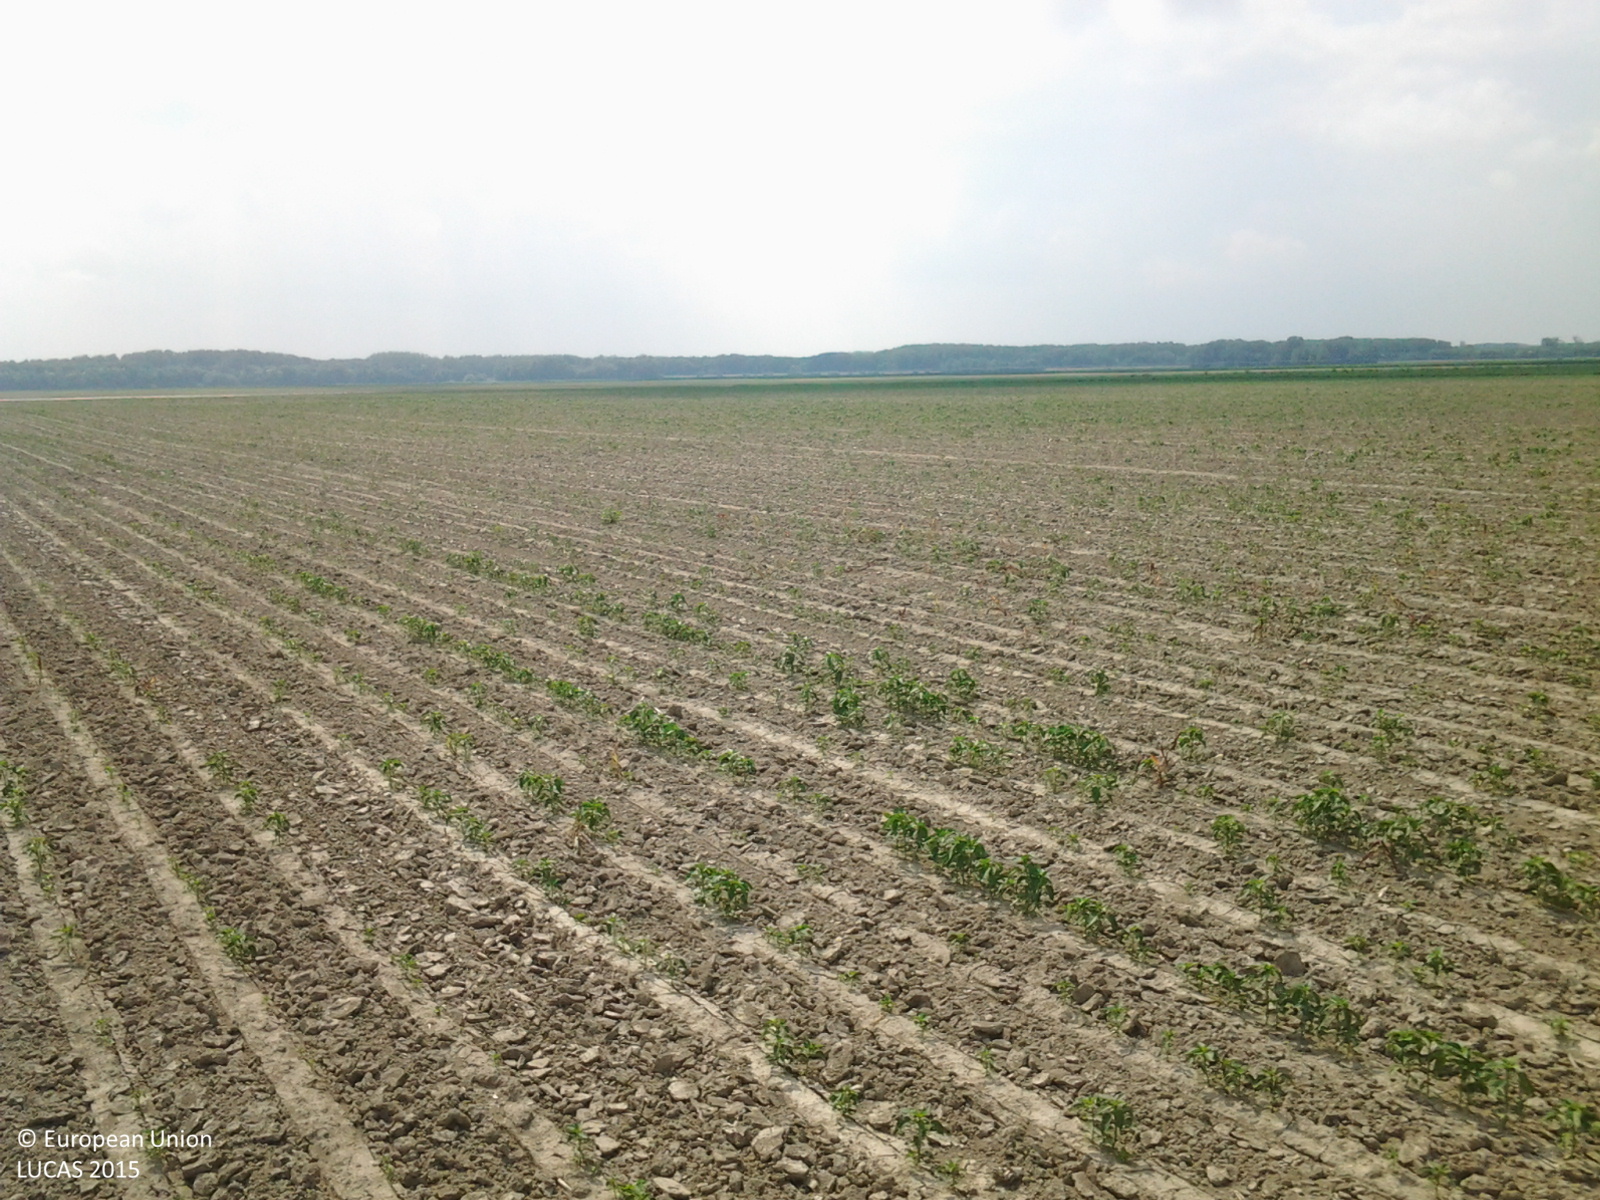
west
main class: Cropland
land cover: Other fresh vegetables
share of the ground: < 10 %
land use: Agriculture (excluding fallow land and kitchen gardens)
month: June
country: HU
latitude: 46.3945
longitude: 18.9212
